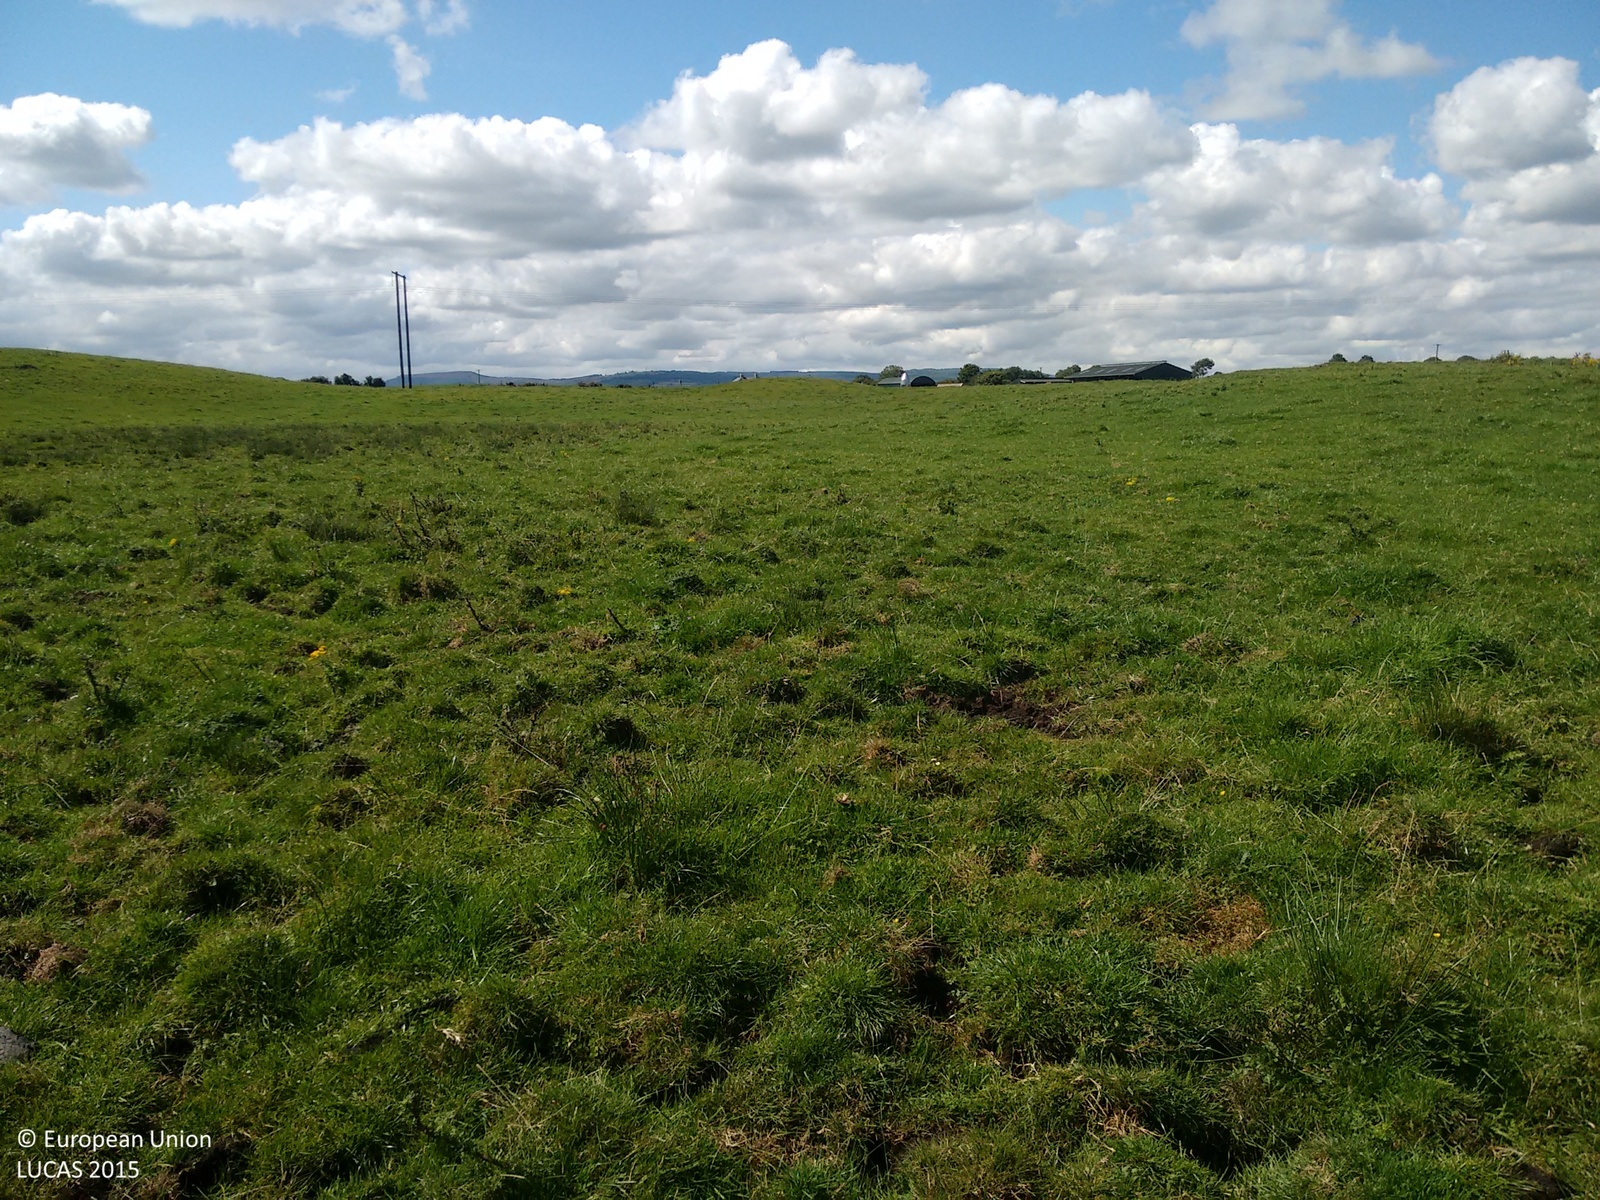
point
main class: Grassland
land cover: Grassland without tree/shrub cover
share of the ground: > 75 %
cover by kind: herbaceous plants 100 %
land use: Agriculture (excluding fallow land and kitchen gardens)
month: August
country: IE
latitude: 52.8473
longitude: -7.7627
